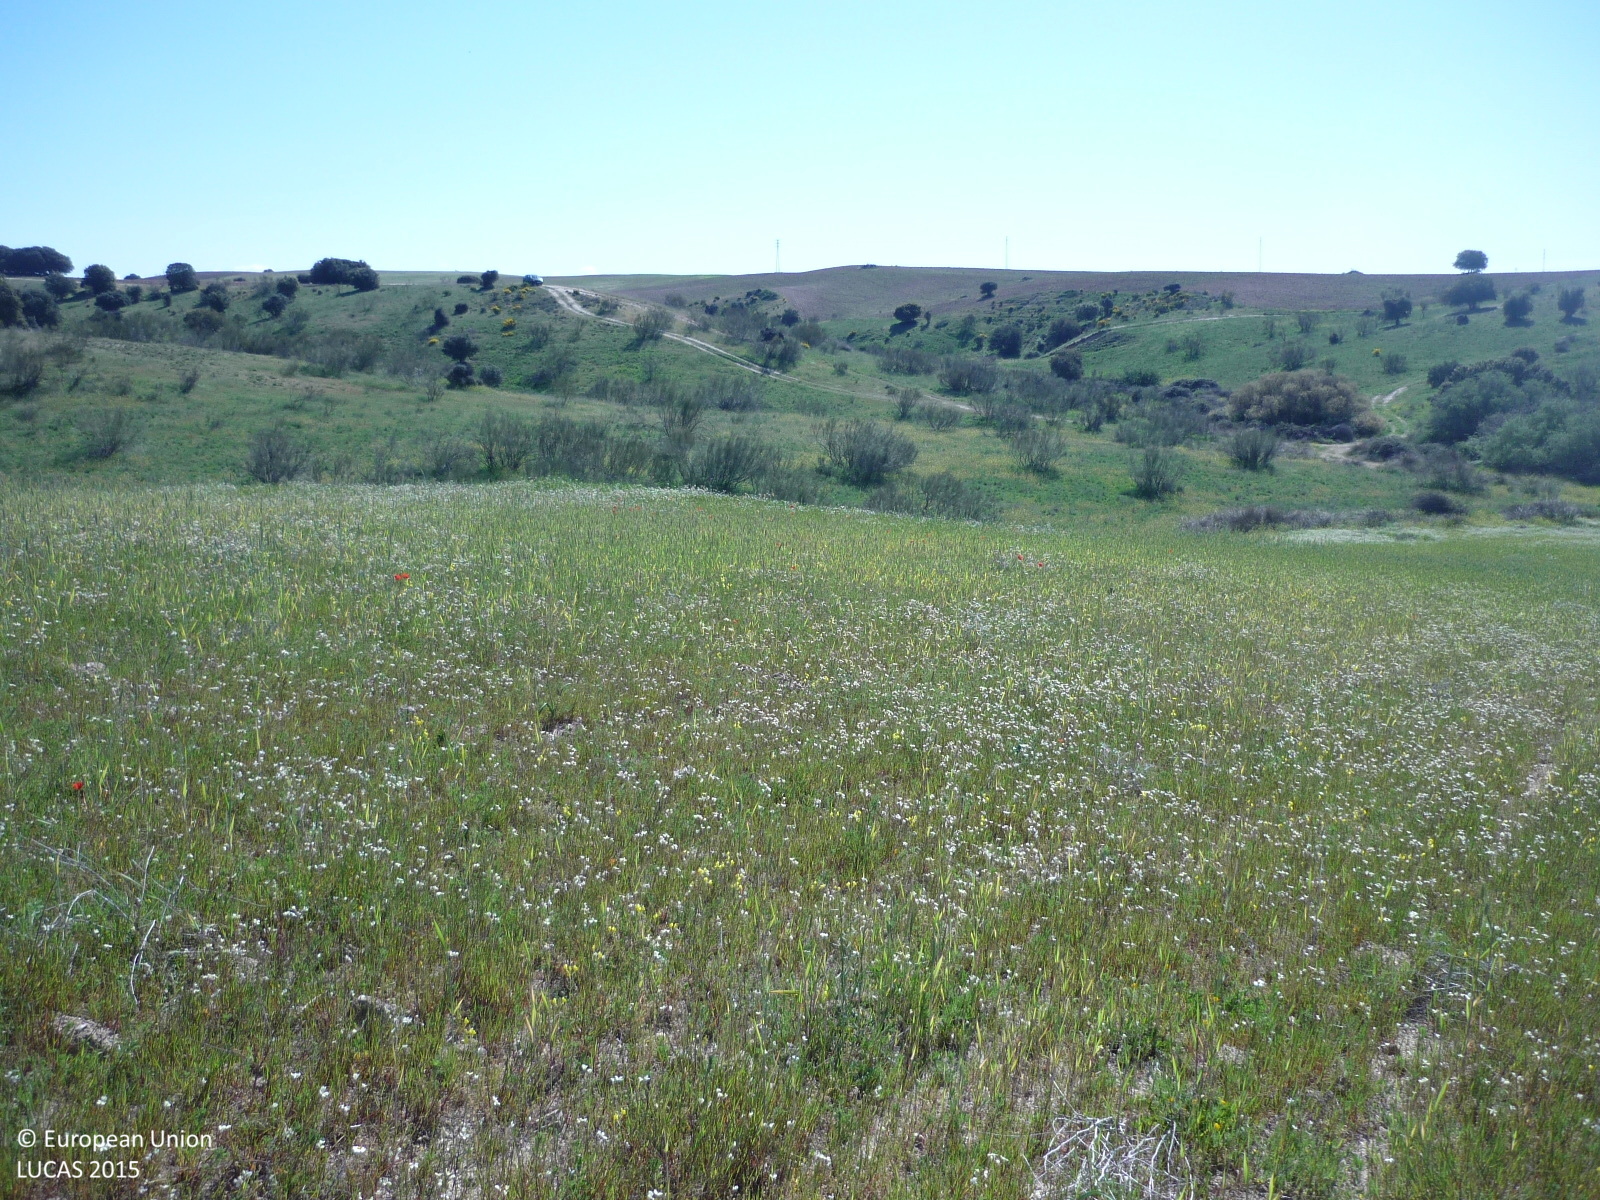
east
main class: Grassland
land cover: Spontaneously vegetated surfaces
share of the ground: > 75 %
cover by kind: herbaceous plants 90 %, unconsolidated bare surface 10 %
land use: Fallow land
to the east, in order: Spontaneously vegetated surfaces; Grassland with sparse tree/shrub cover; Tracks; Shrubland without tree cover; Grassland with sparse tree/shrub cover; Shrubland without tree cover; Grassland with sparse tree/shrub cover; Tracks; Shrubland without tree cover; Tracks; Shrubland without tree cover
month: April
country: ES
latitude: 40.6550
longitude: -3.5809
